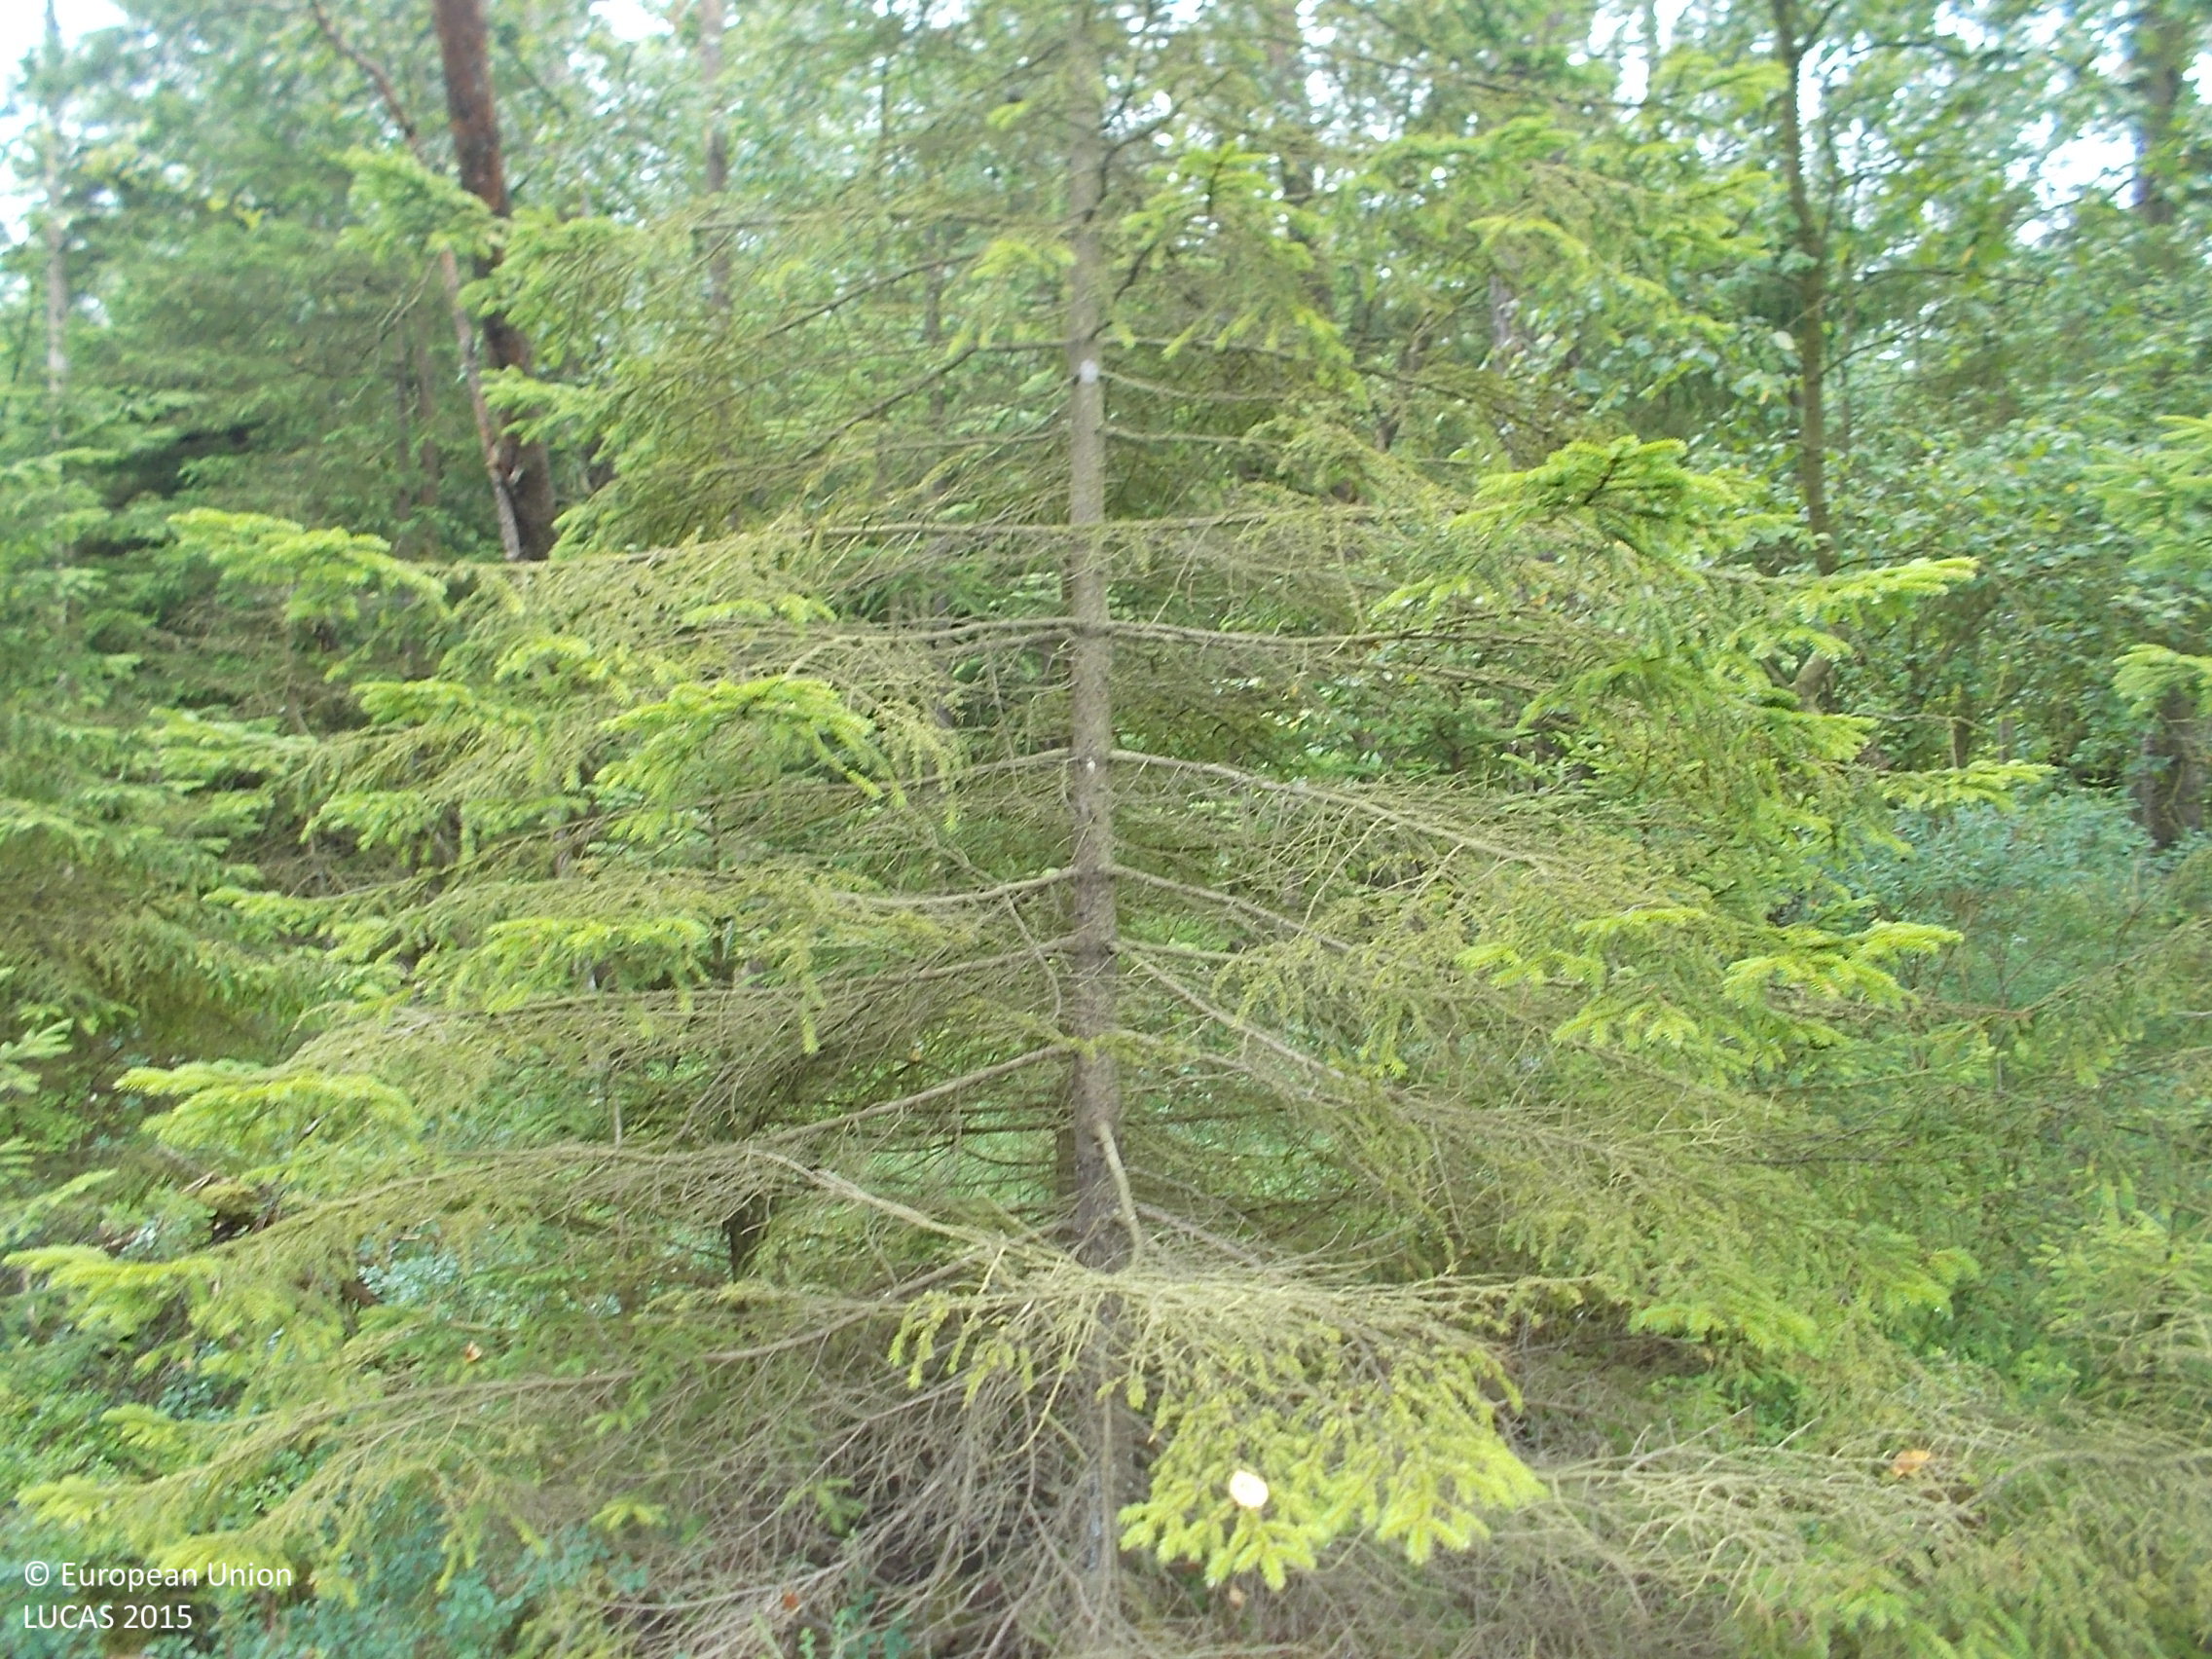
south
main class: Woodland
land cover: Pine dominated mixed woodland
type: boreal forest
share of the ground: > 75 %
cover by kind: coniferous forest trees 60 %, broadleaved forest trees 25 %, shrubs 10 %, lichens and mosses 5 %
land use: Semi-natural and natural areas not in use
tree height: > 5 m
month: August
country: SE
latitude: 57.5164
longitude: 12.2836
